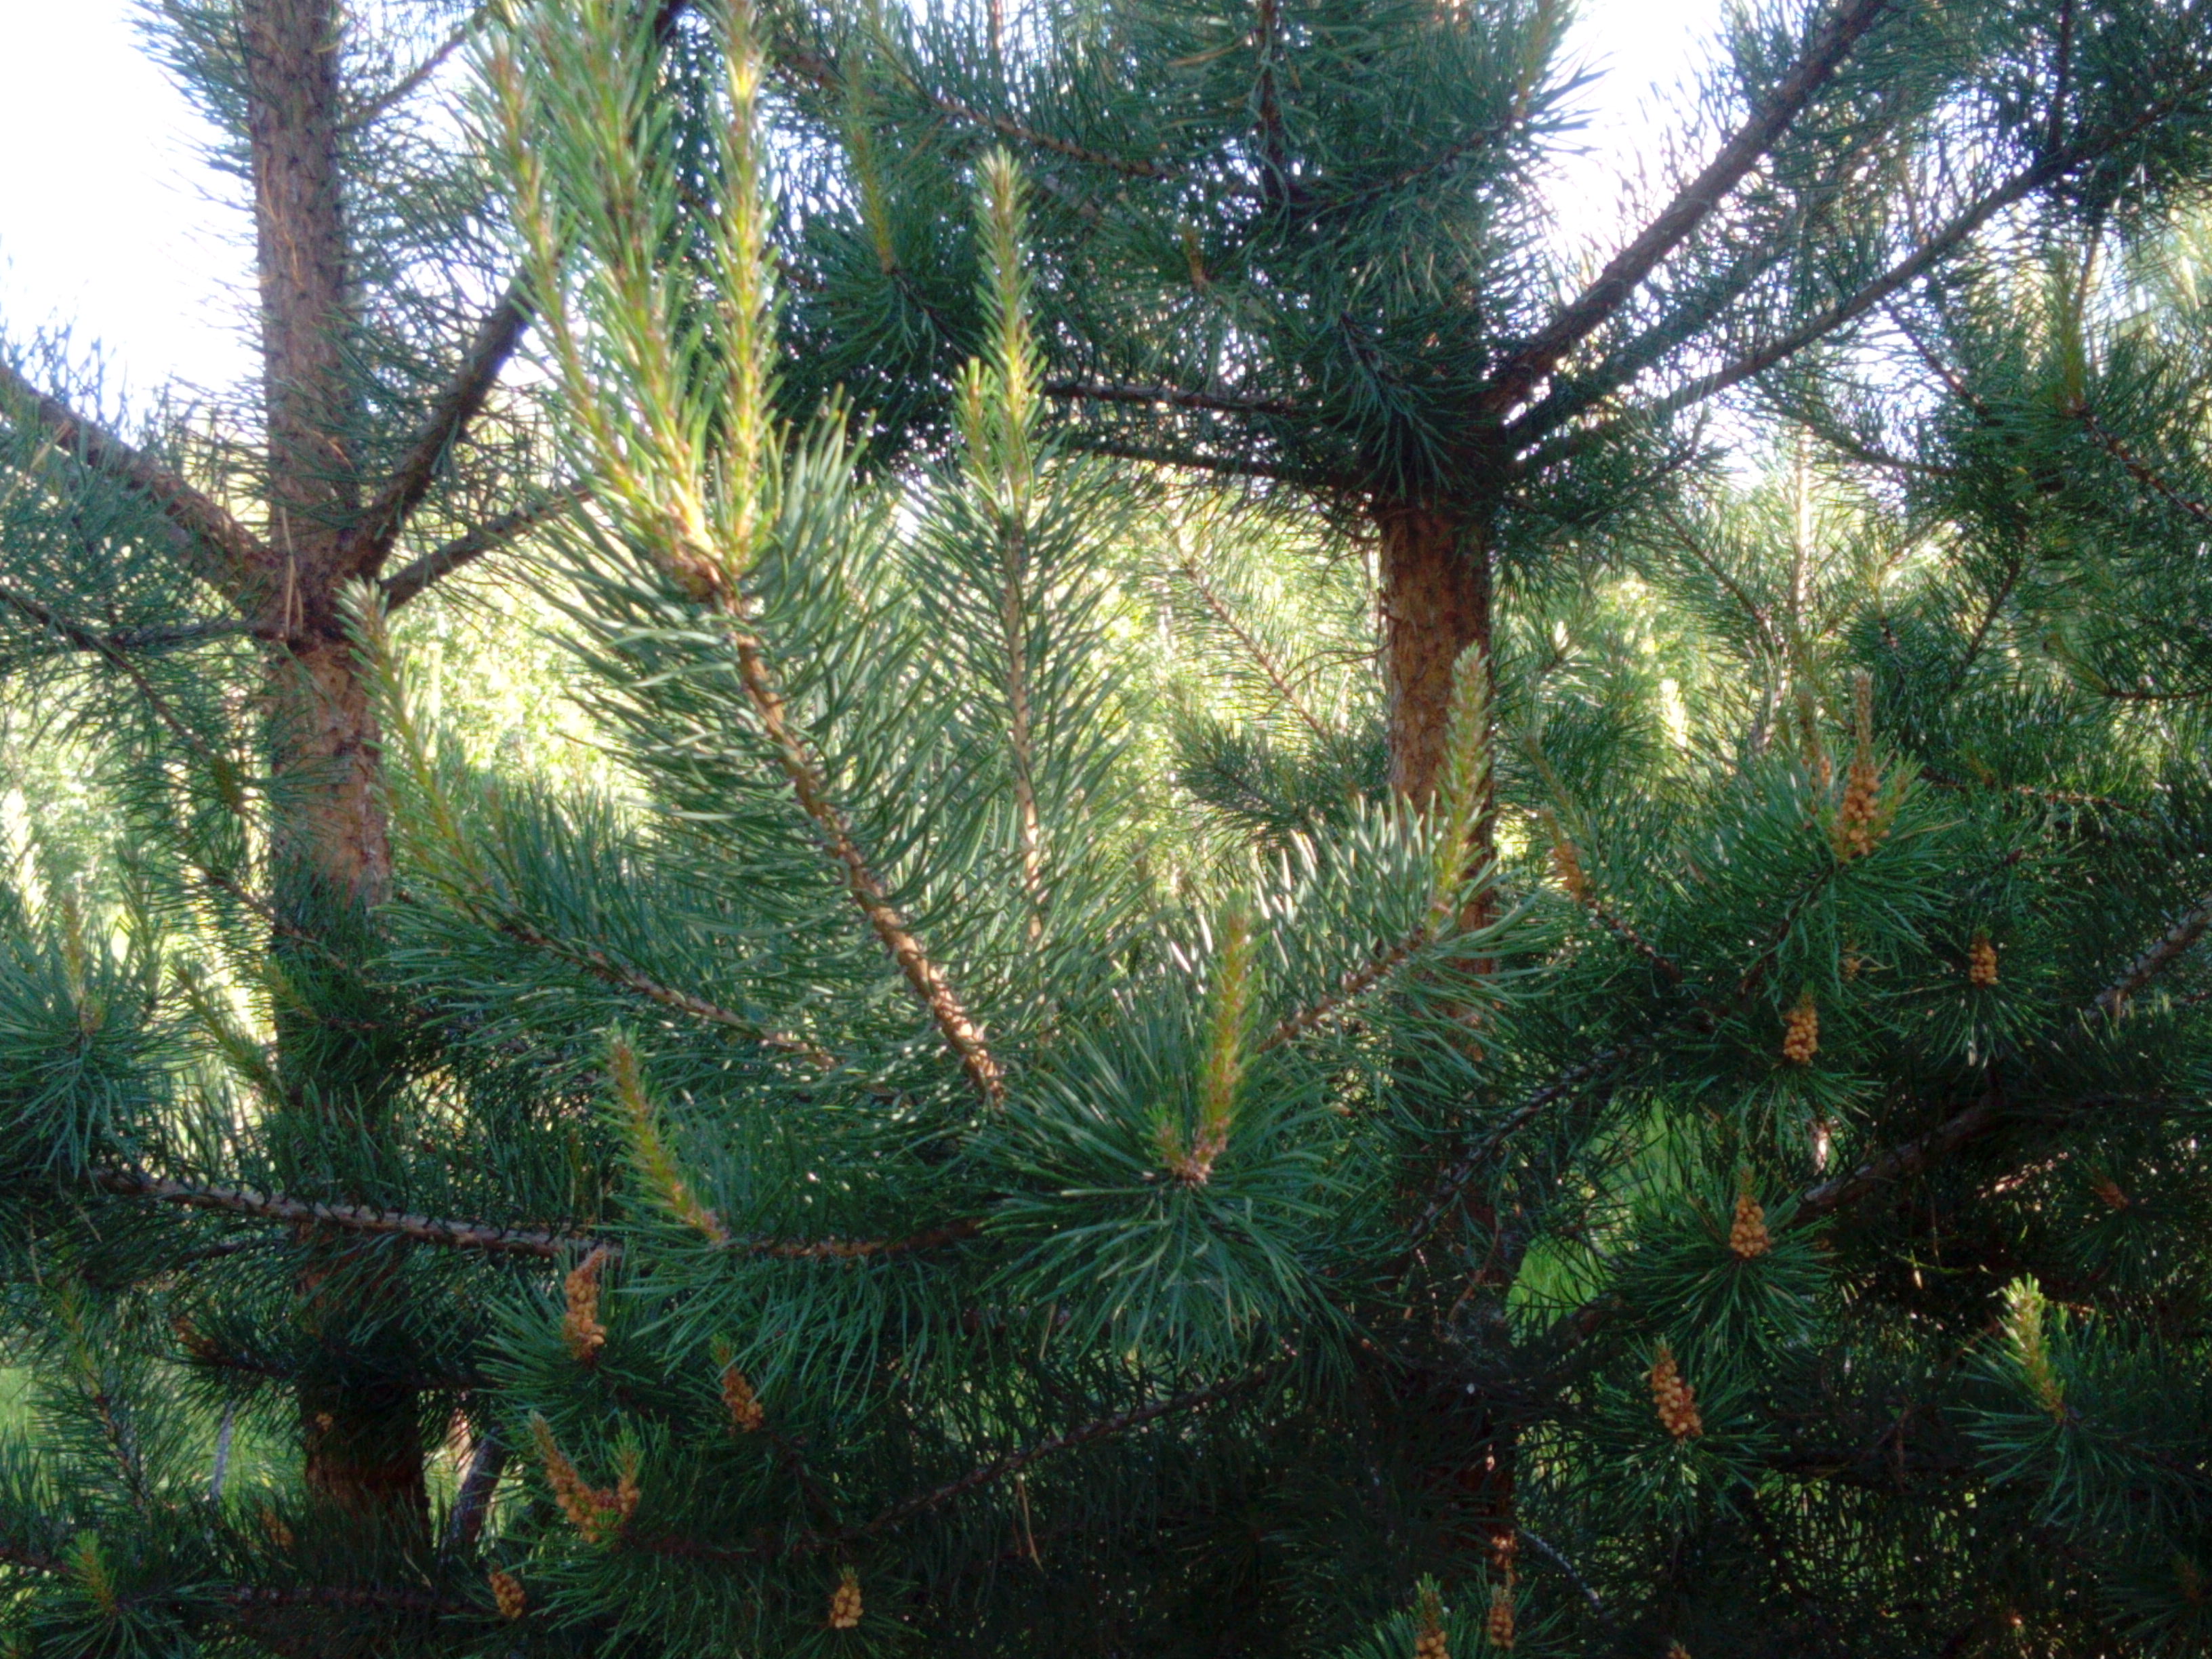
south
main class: Woodland
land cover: Pine dominated coniferous woodland
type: hemiboreal forest and nemoral coniferous forest and mixed broadleaved-coniferous forest
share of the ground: 50 - 75 %
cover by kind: coniferous forest trees 50 %, herbaceous plants 50 %
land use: Forestry
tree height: < 5 m
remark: Nursery
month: June
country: LV
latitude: 56.7208
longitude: 22.1260
